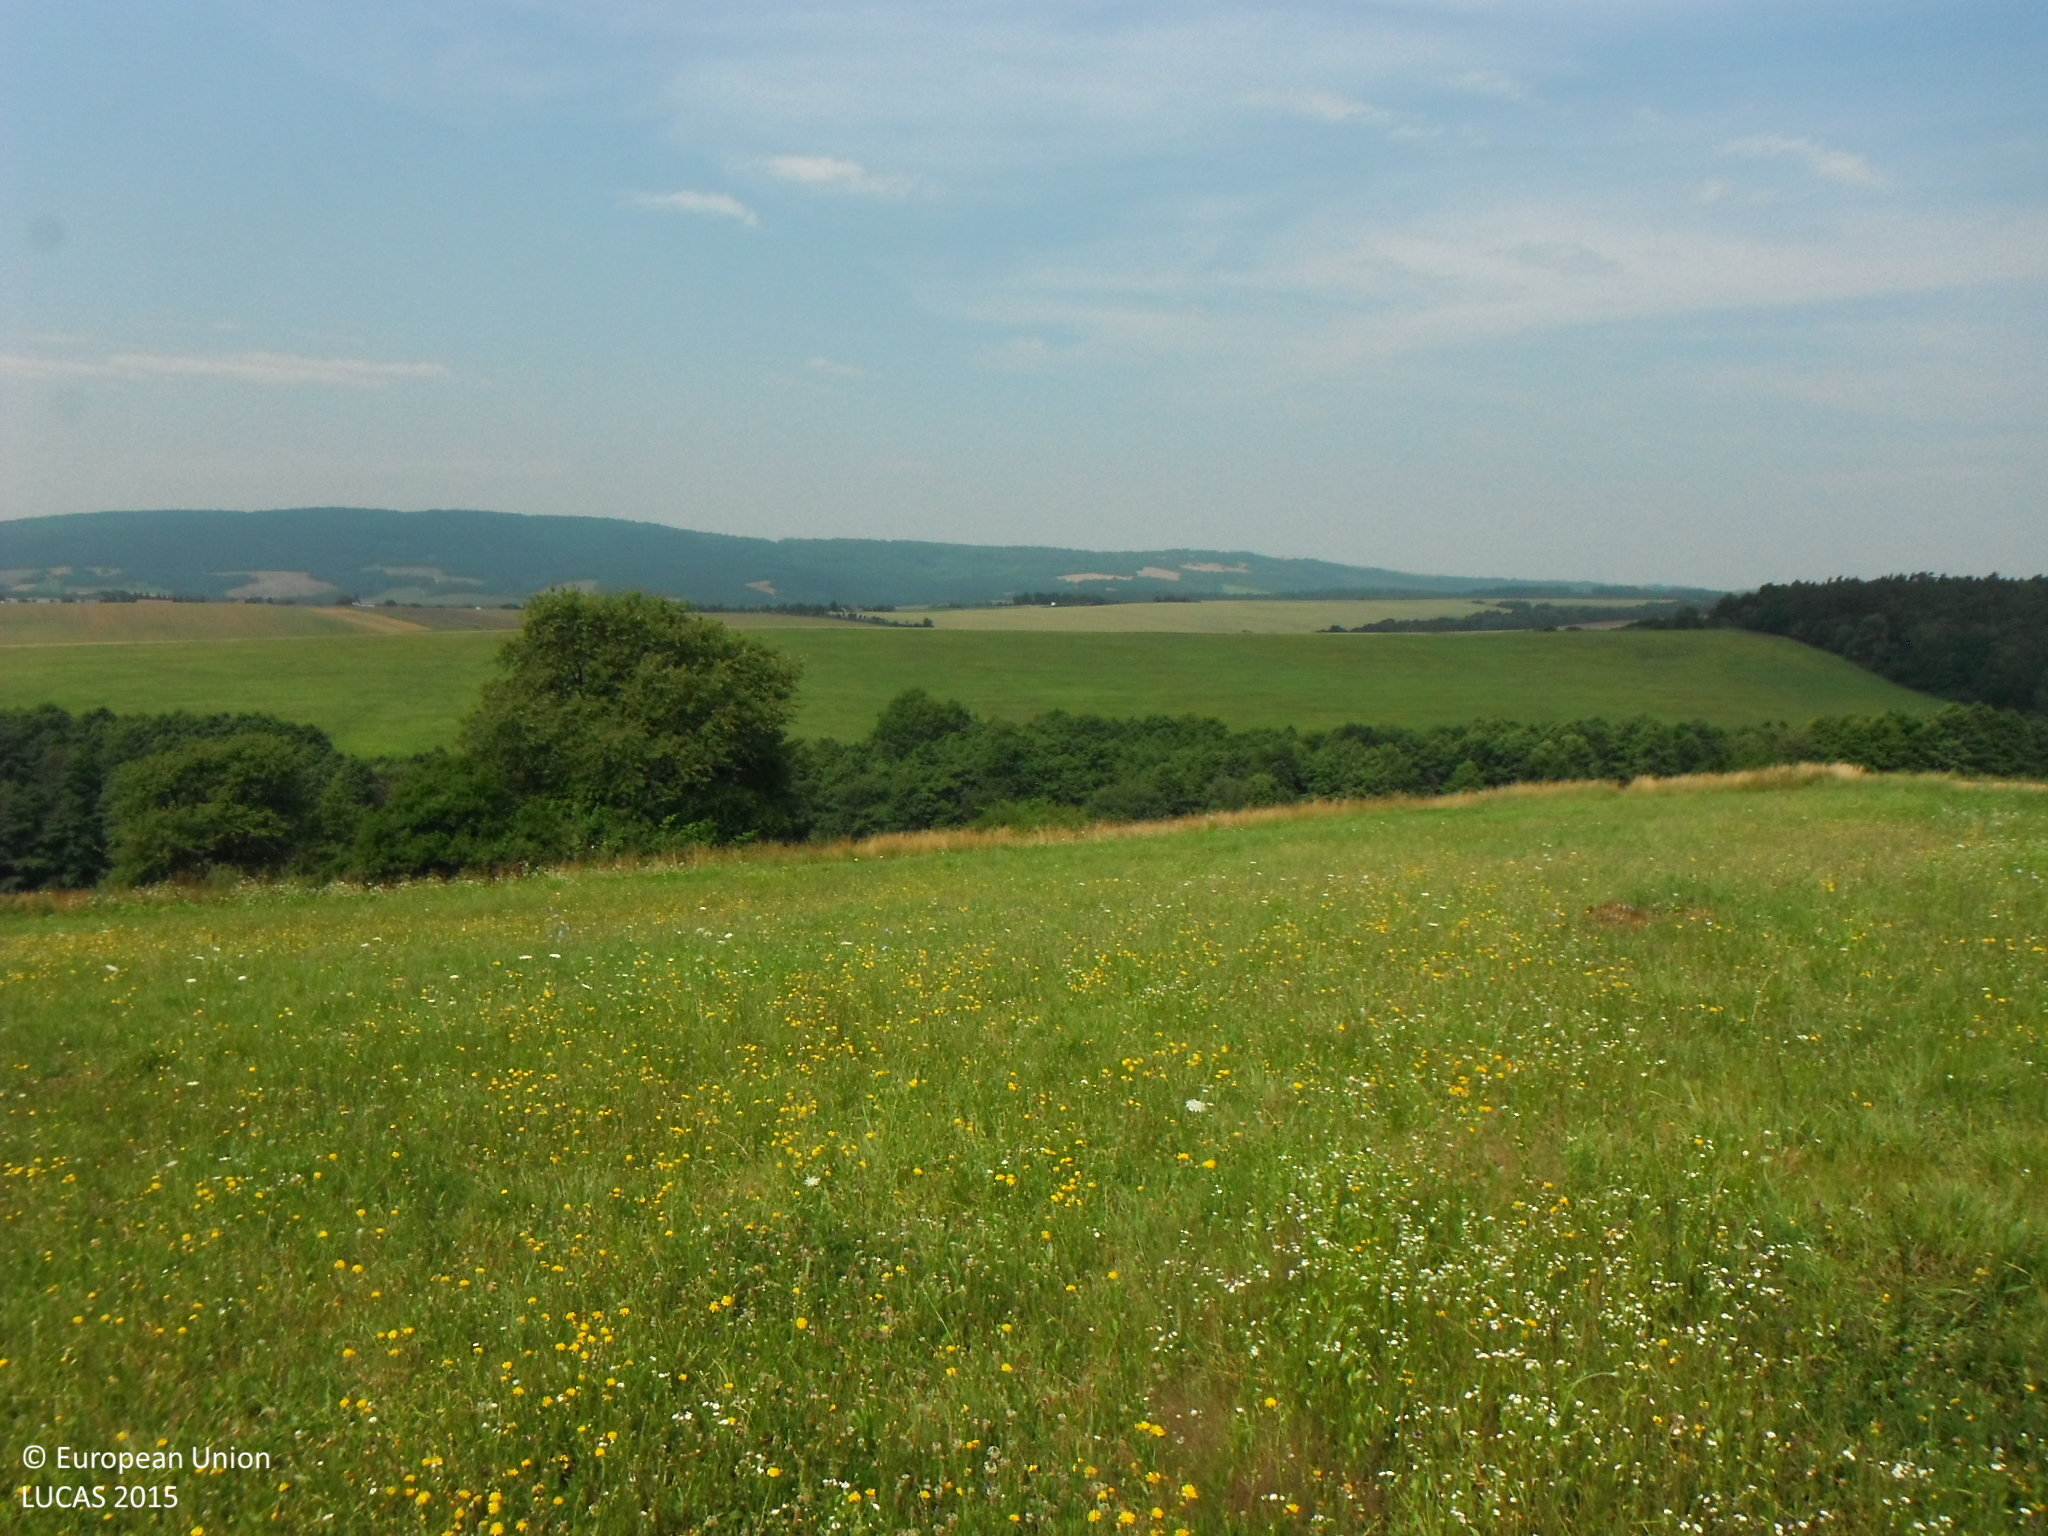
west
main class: Grassland
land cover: Grassland without tree/shrub cover
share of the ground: > 75 %
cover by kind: herbaceous plants 90 %, unconsolidated bare surface 10 %
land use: Agriculture (excluding fallow land and kitchen gardens)
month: July
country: SK
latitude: 49.2079
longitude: 21.4269
